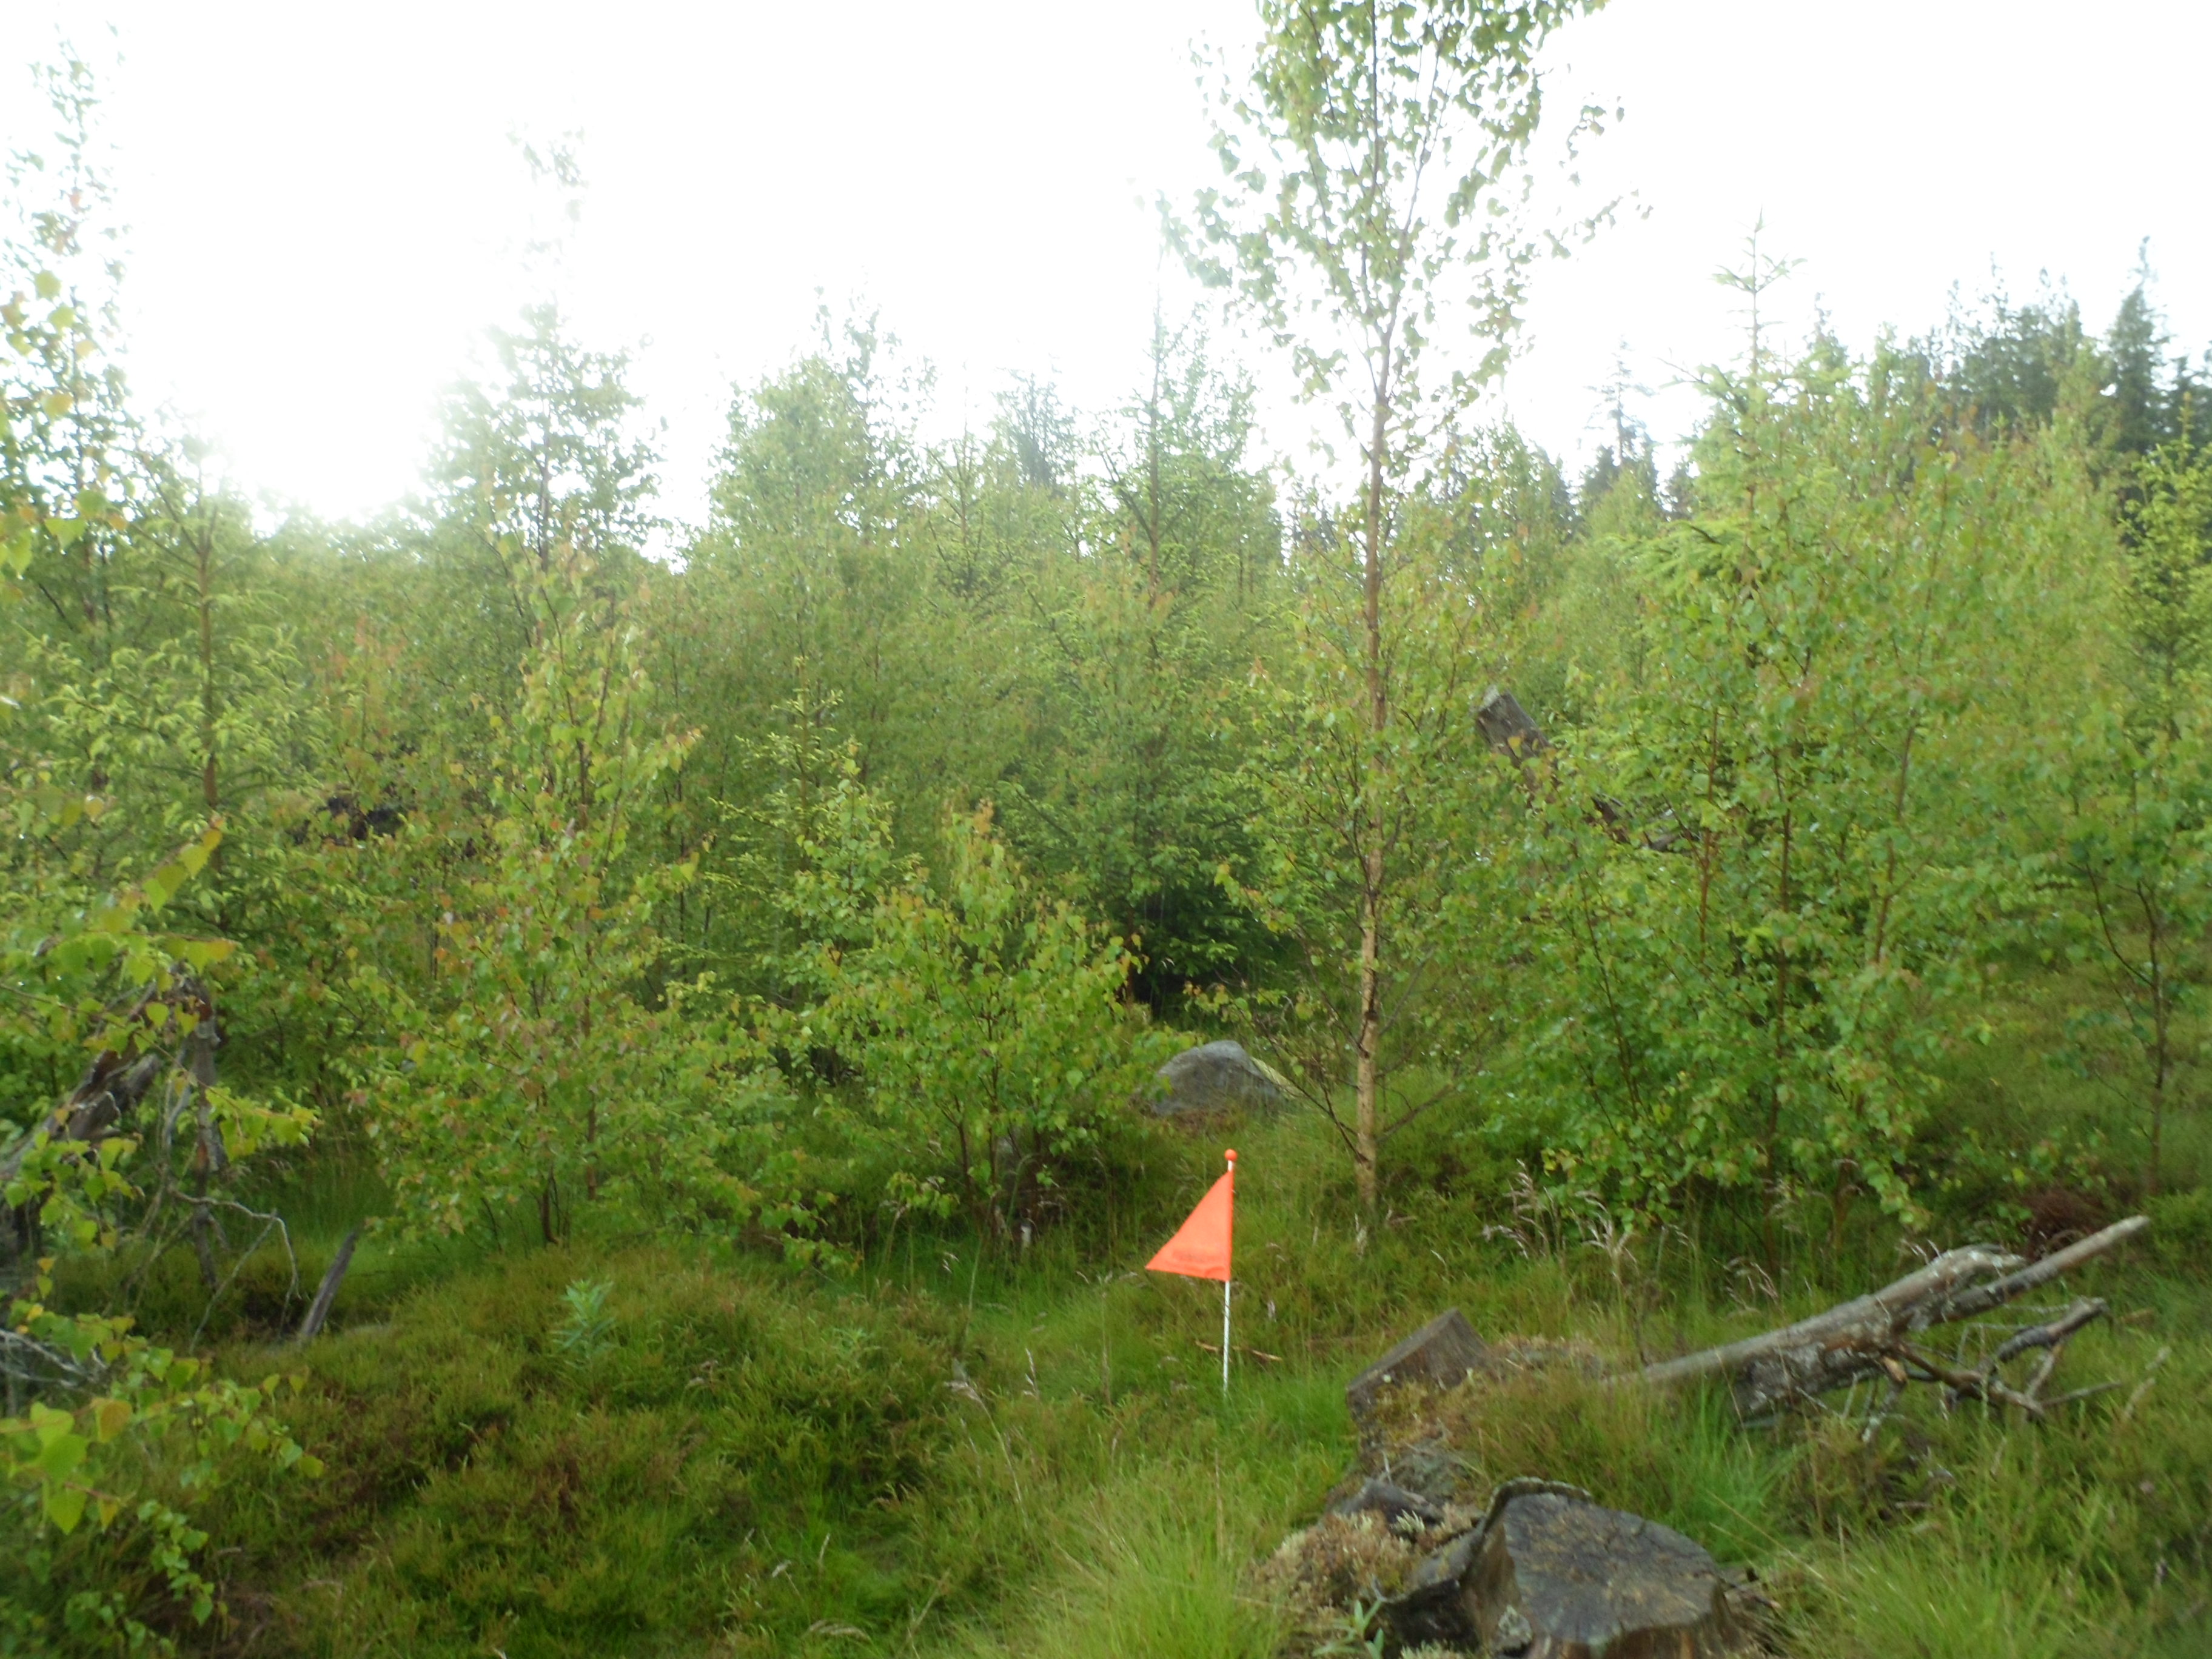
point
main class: Woodland
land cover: Spruce dominated mixed woodland
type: boreal forest
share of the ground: 50 - 75 %
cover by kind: broadleaved forest trees 35 %, coniferous forest trees 25 %, shrubs 20 %, herbaceous plants 15 %, lichens and mosses 5 %
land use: Forestry
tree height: < 5 m
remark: Clear cut
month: June
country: SE
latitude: 56.8874
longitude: 14.3790
